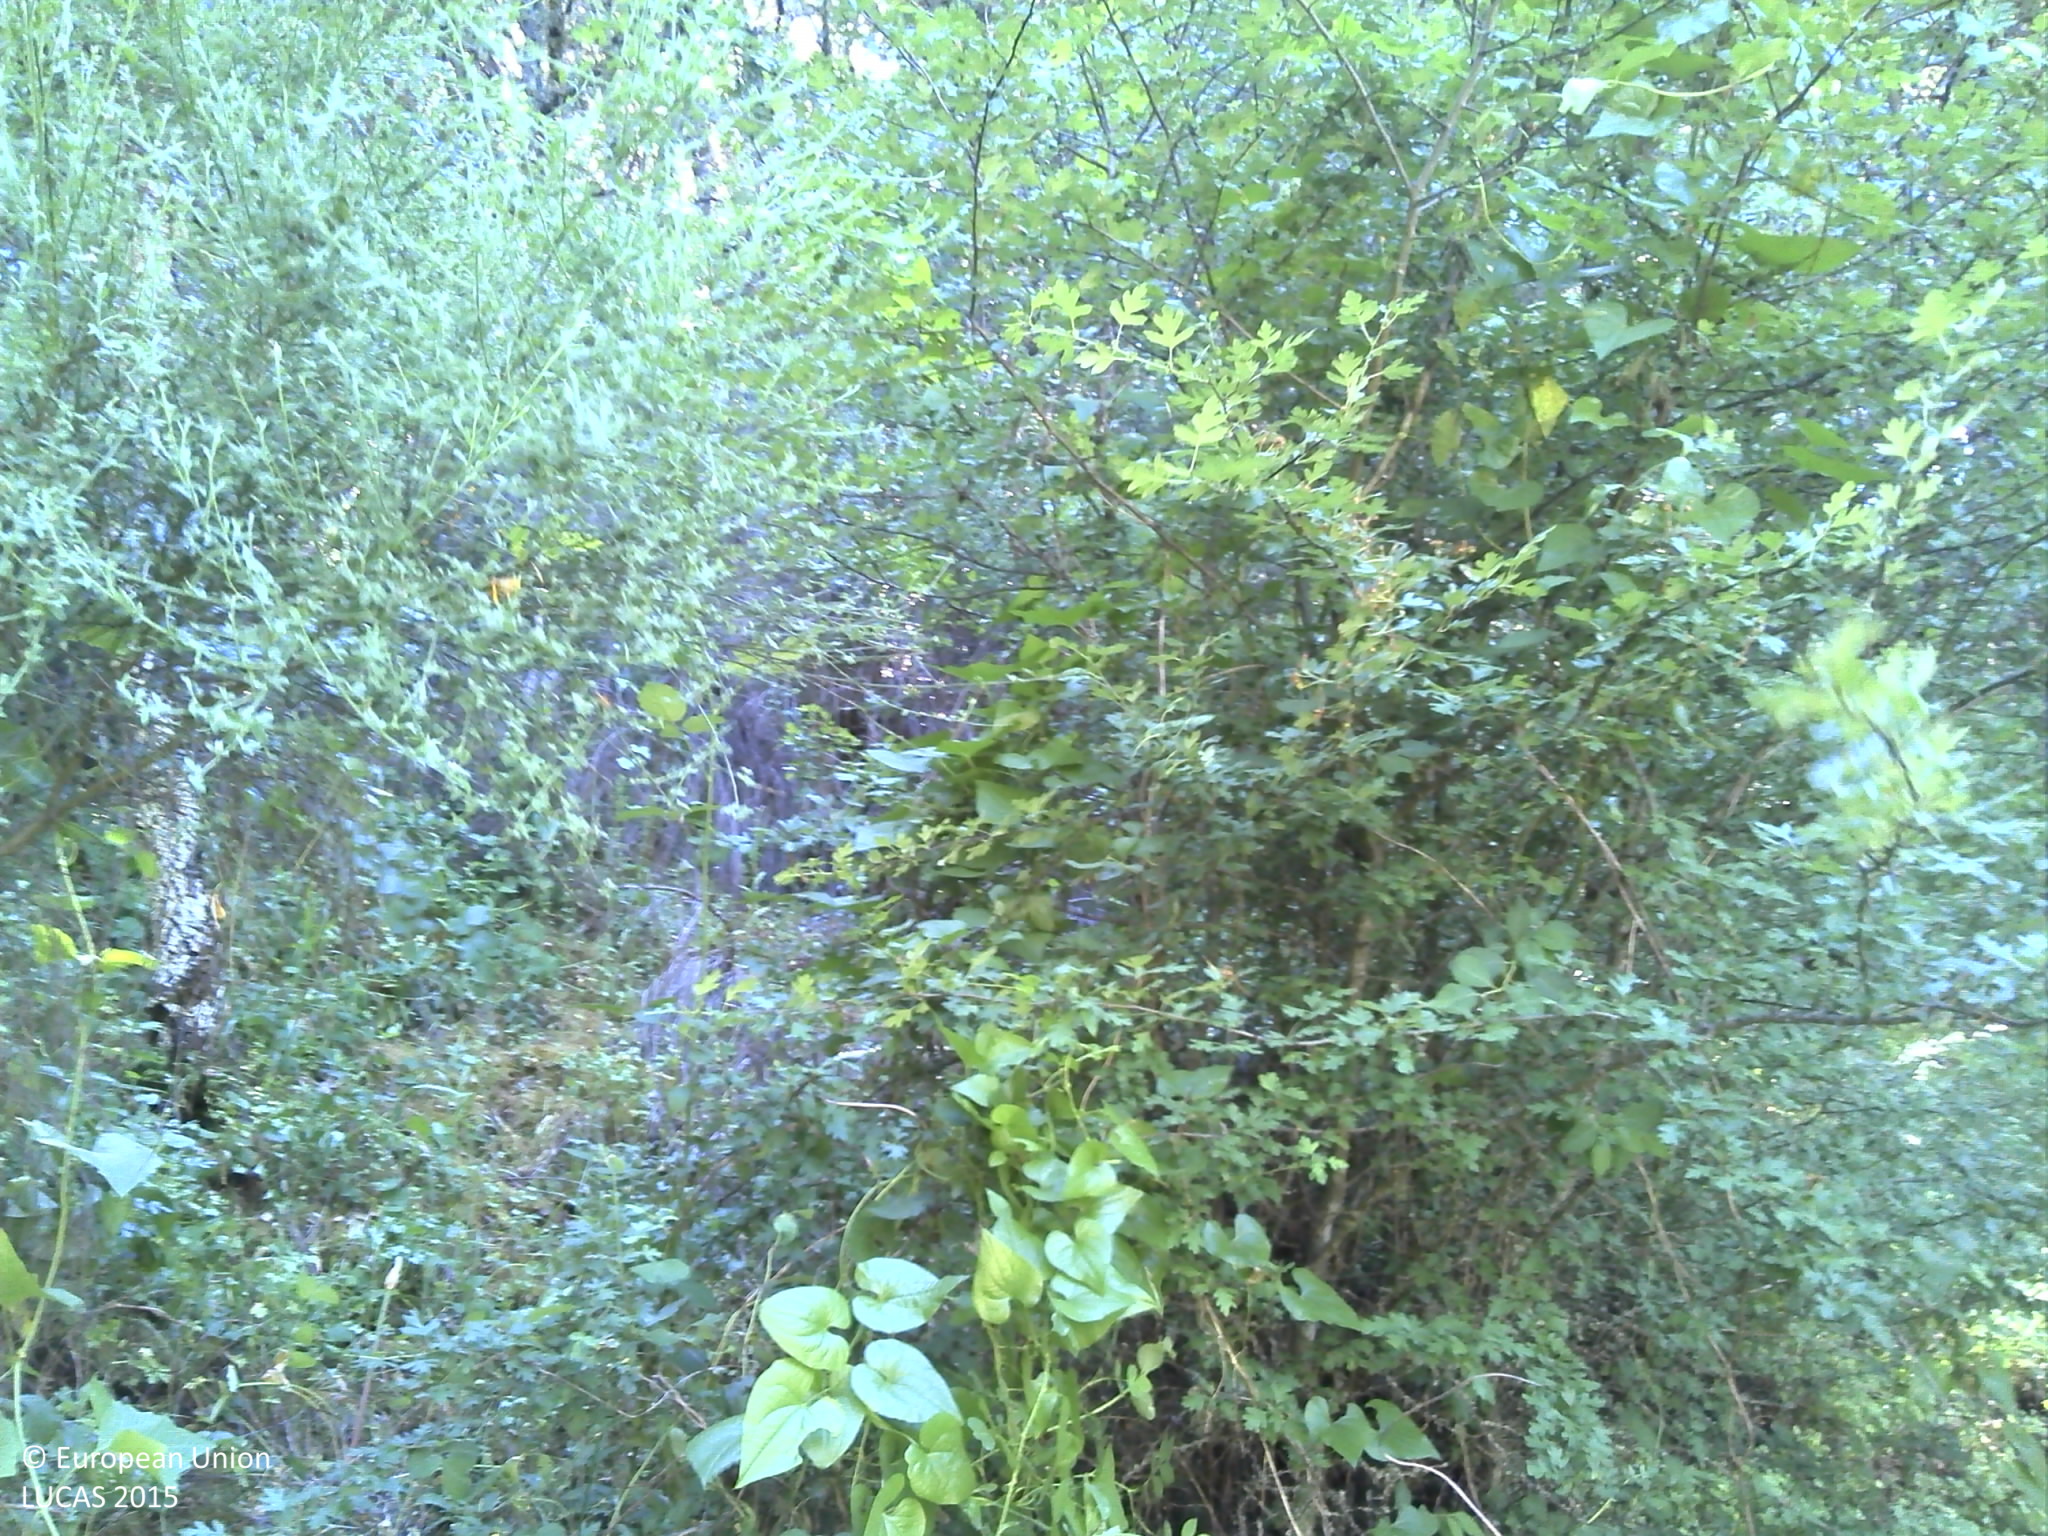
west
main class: Woodland
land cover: Broadleaved woodland
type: thermophilous deciduous forest
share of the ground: > 75 %
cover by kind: shrubs 50 %, broadleaved forest trees 25 %, herbaceous plants 20 %, coniferous forest trees 5 %
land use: Forestry
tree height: > 5 m
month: May
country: PT
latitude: 41.7520
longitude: -6.5965
